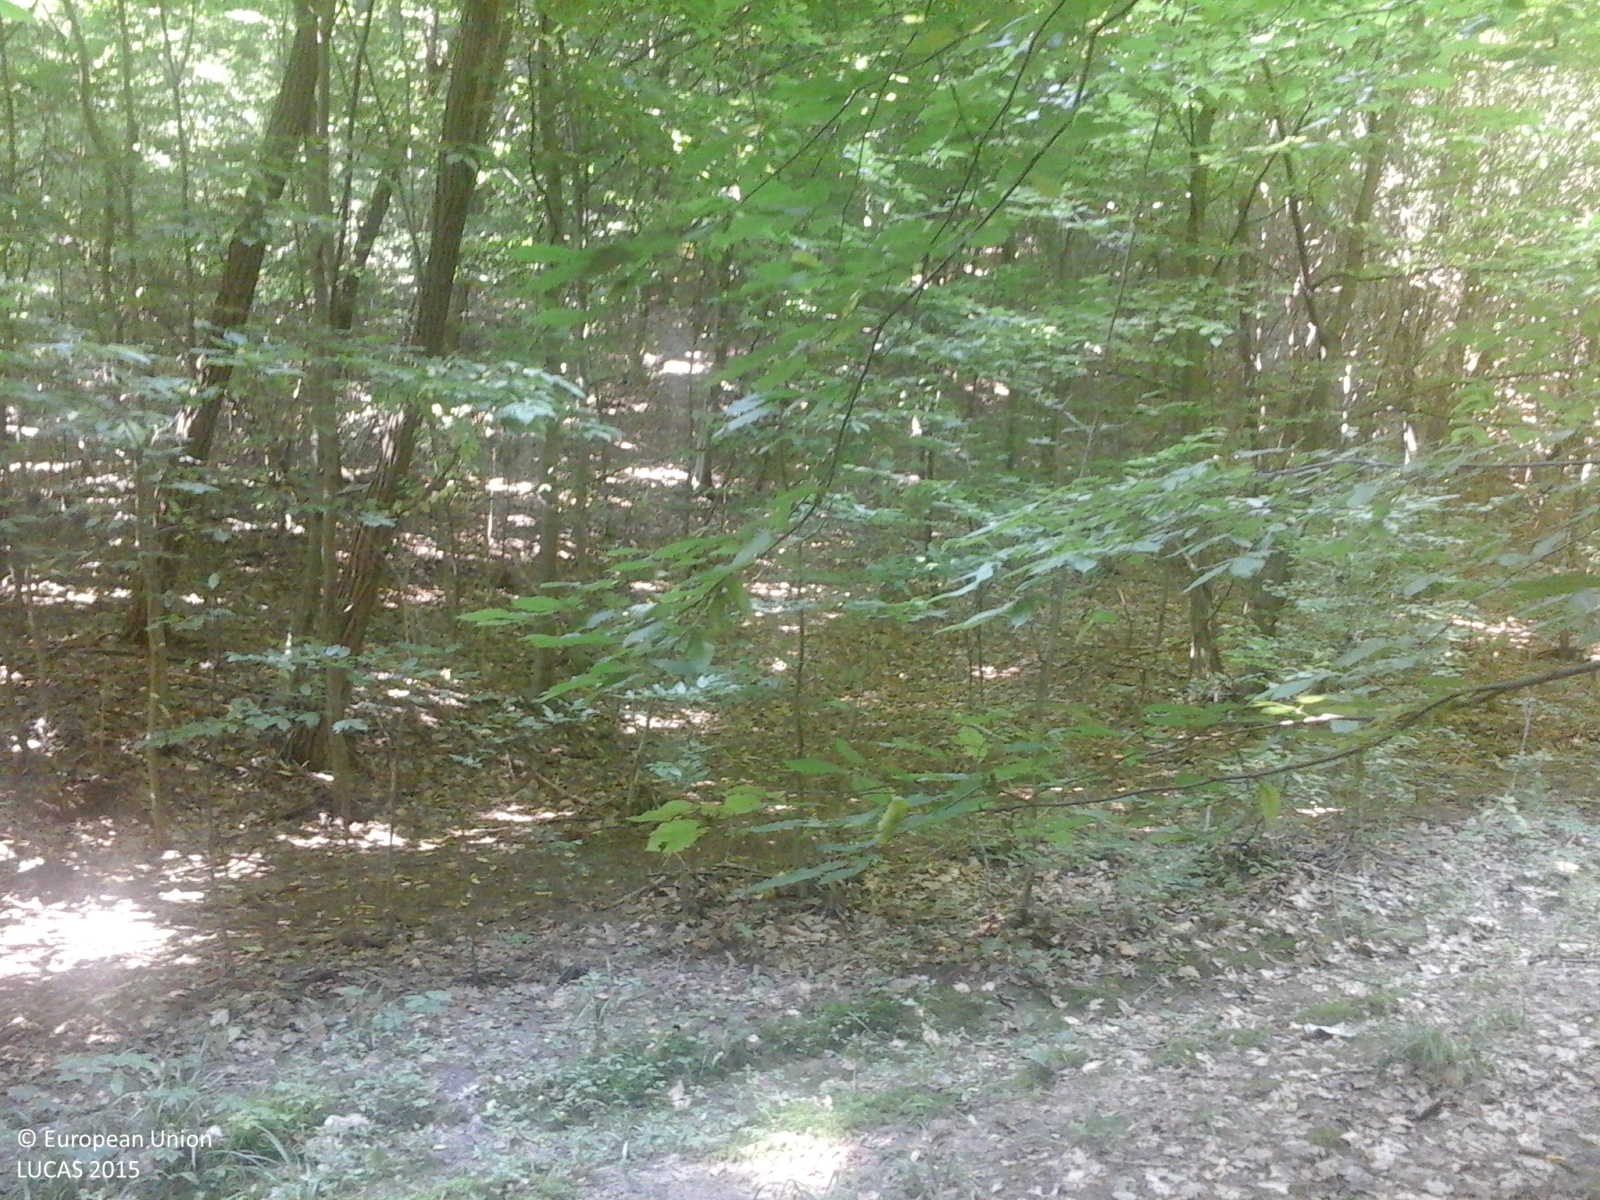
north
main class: Woodland
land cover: Broadleaved woodland
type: mesophytic deciduous forest
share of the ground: > 75 %
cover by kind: broadleaved forest trees 100 %
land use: Forestry
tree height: > 5 m
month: July
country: RO
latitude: 44.7728
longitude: 24.7488
